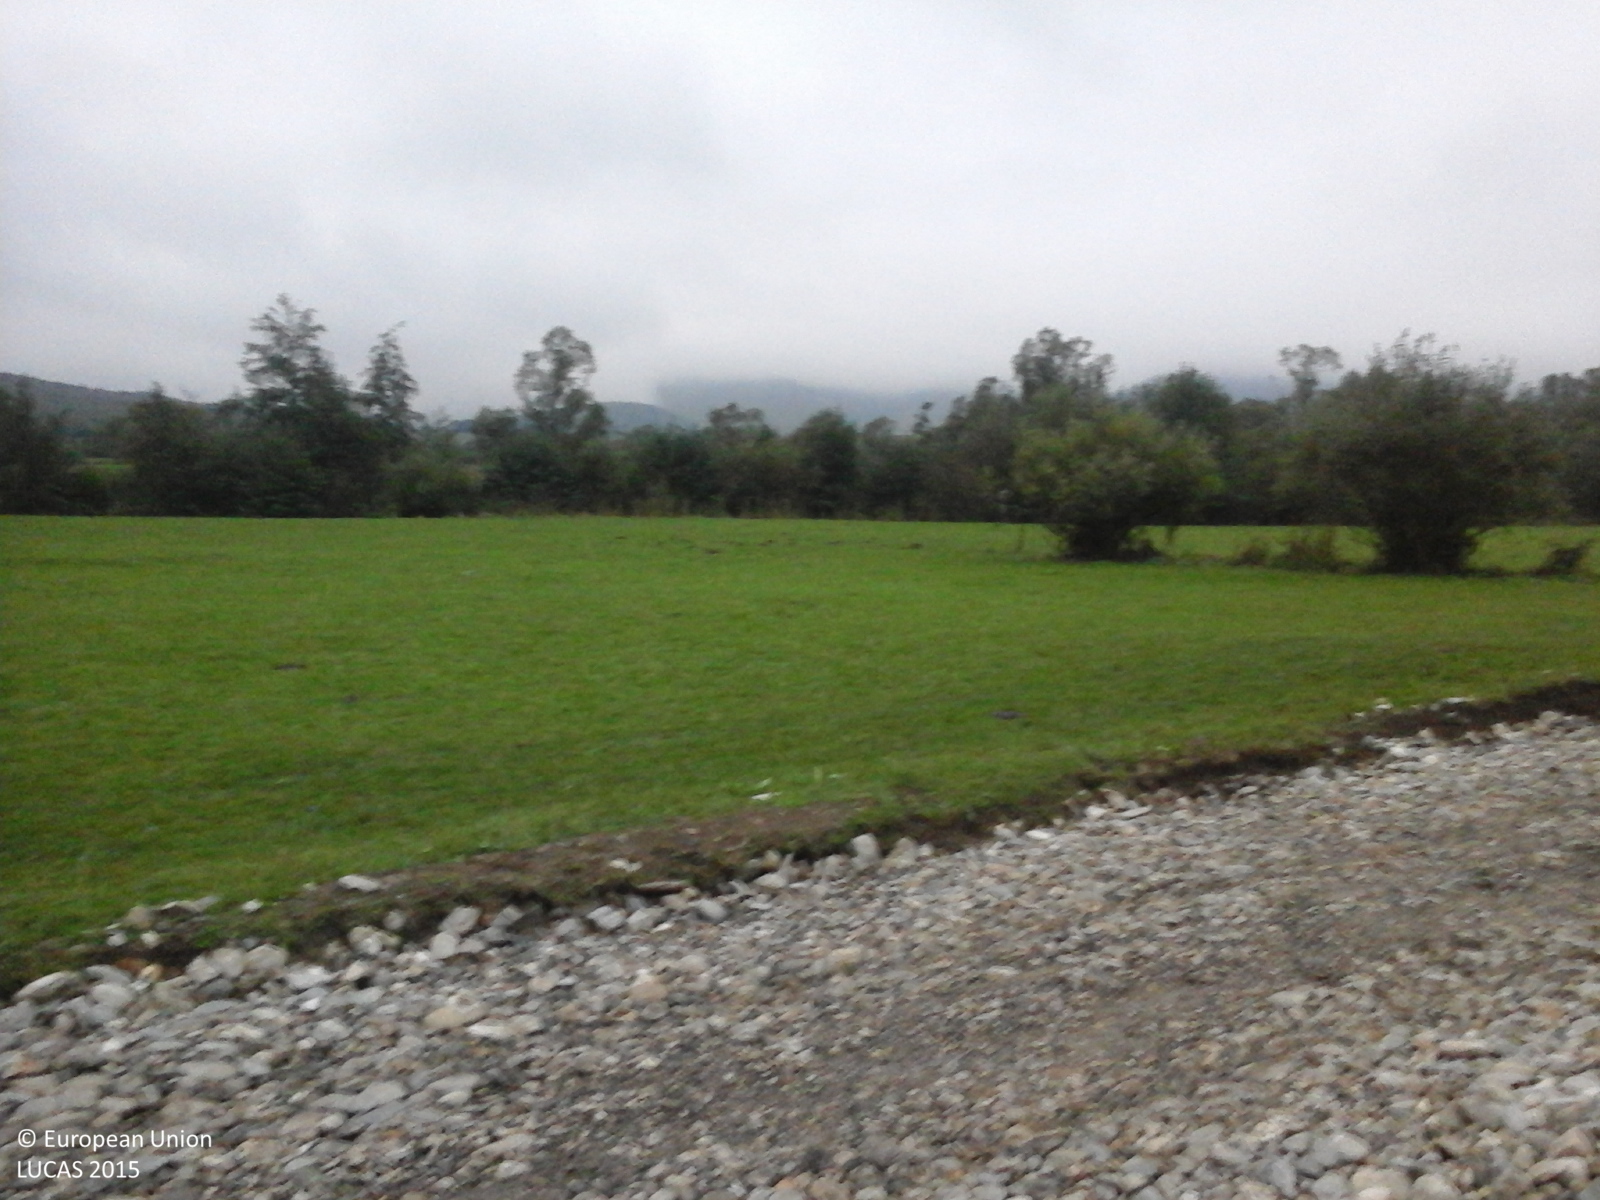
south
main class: Grassland
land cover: Grassland without tree/shrub cover
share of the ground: > 75 %
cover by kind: herbaceous plants 100 %
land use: Agriculture (excluding fallow land and kitchen gardens)
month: October
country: RO
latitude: 45.6955
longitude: 24.1622
